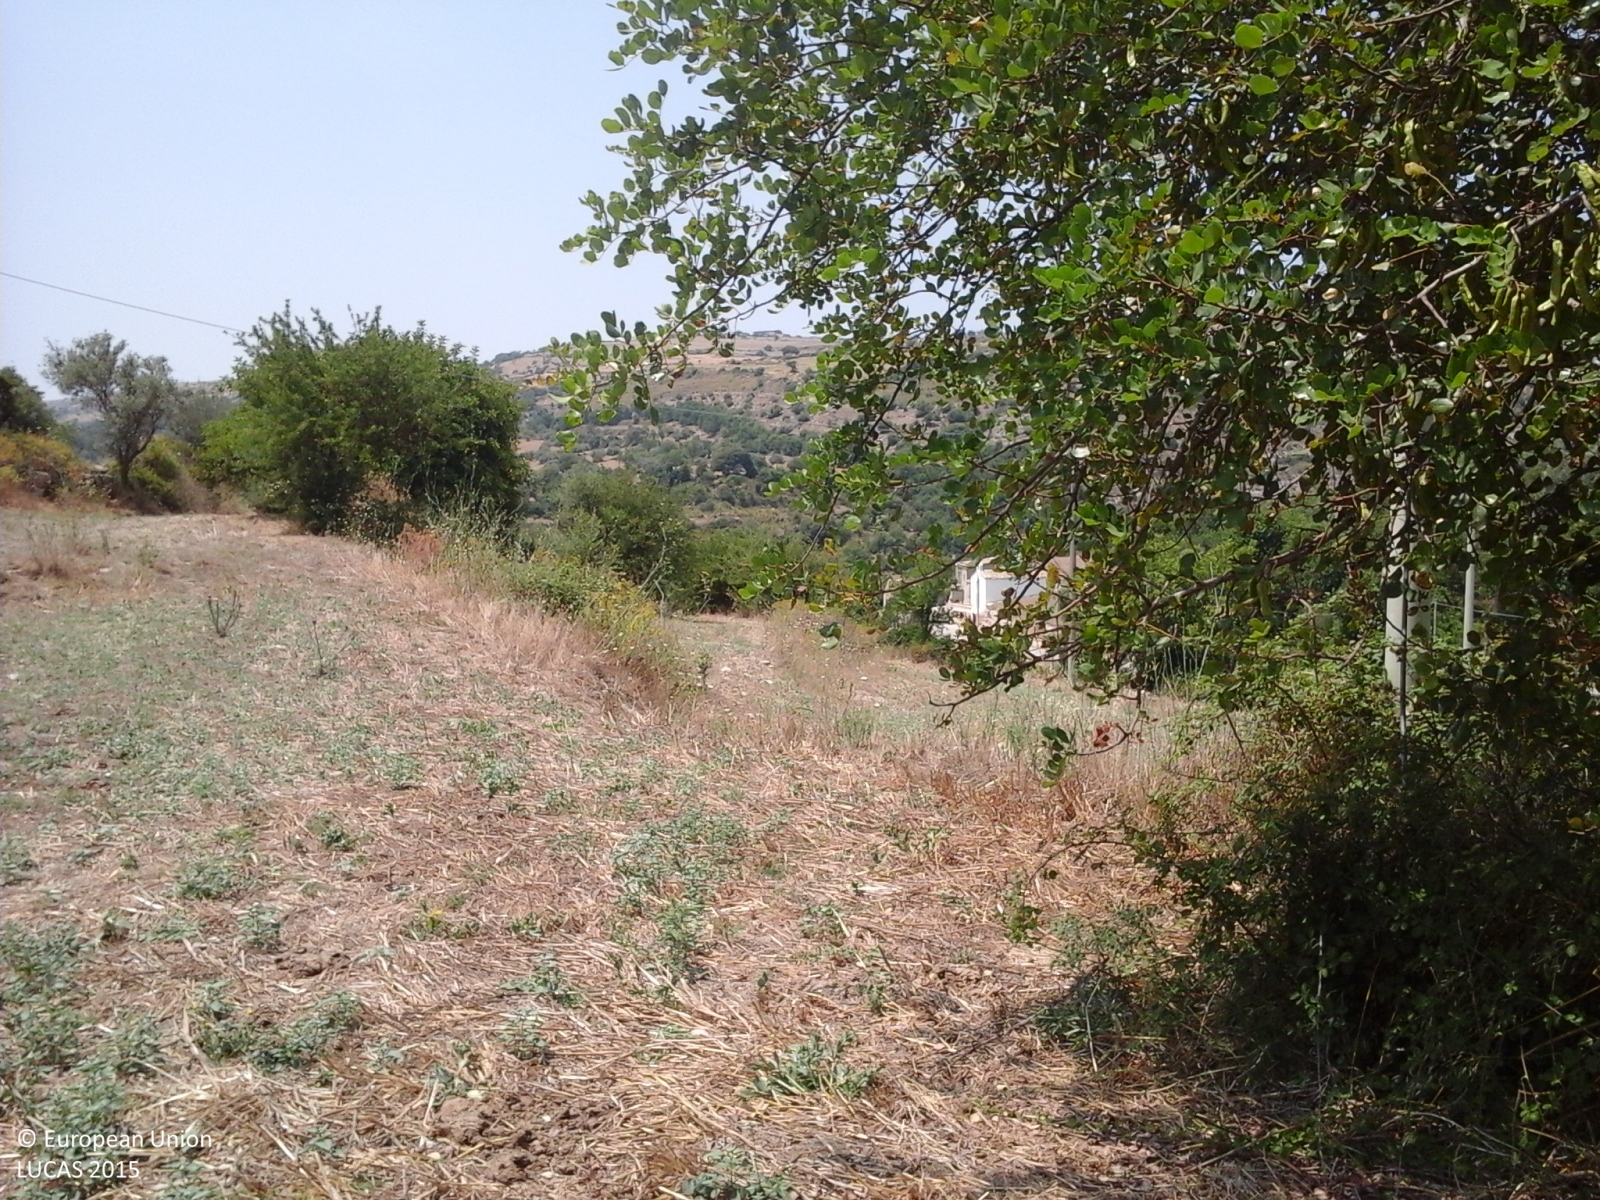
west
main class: Cropland
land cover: Mixed cereals for fodder
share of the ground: > 75 %
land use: Agriculture (excluding fallow land and kitchen gardens)
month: July
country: IT
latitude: 36.9736
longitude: 14.7591
